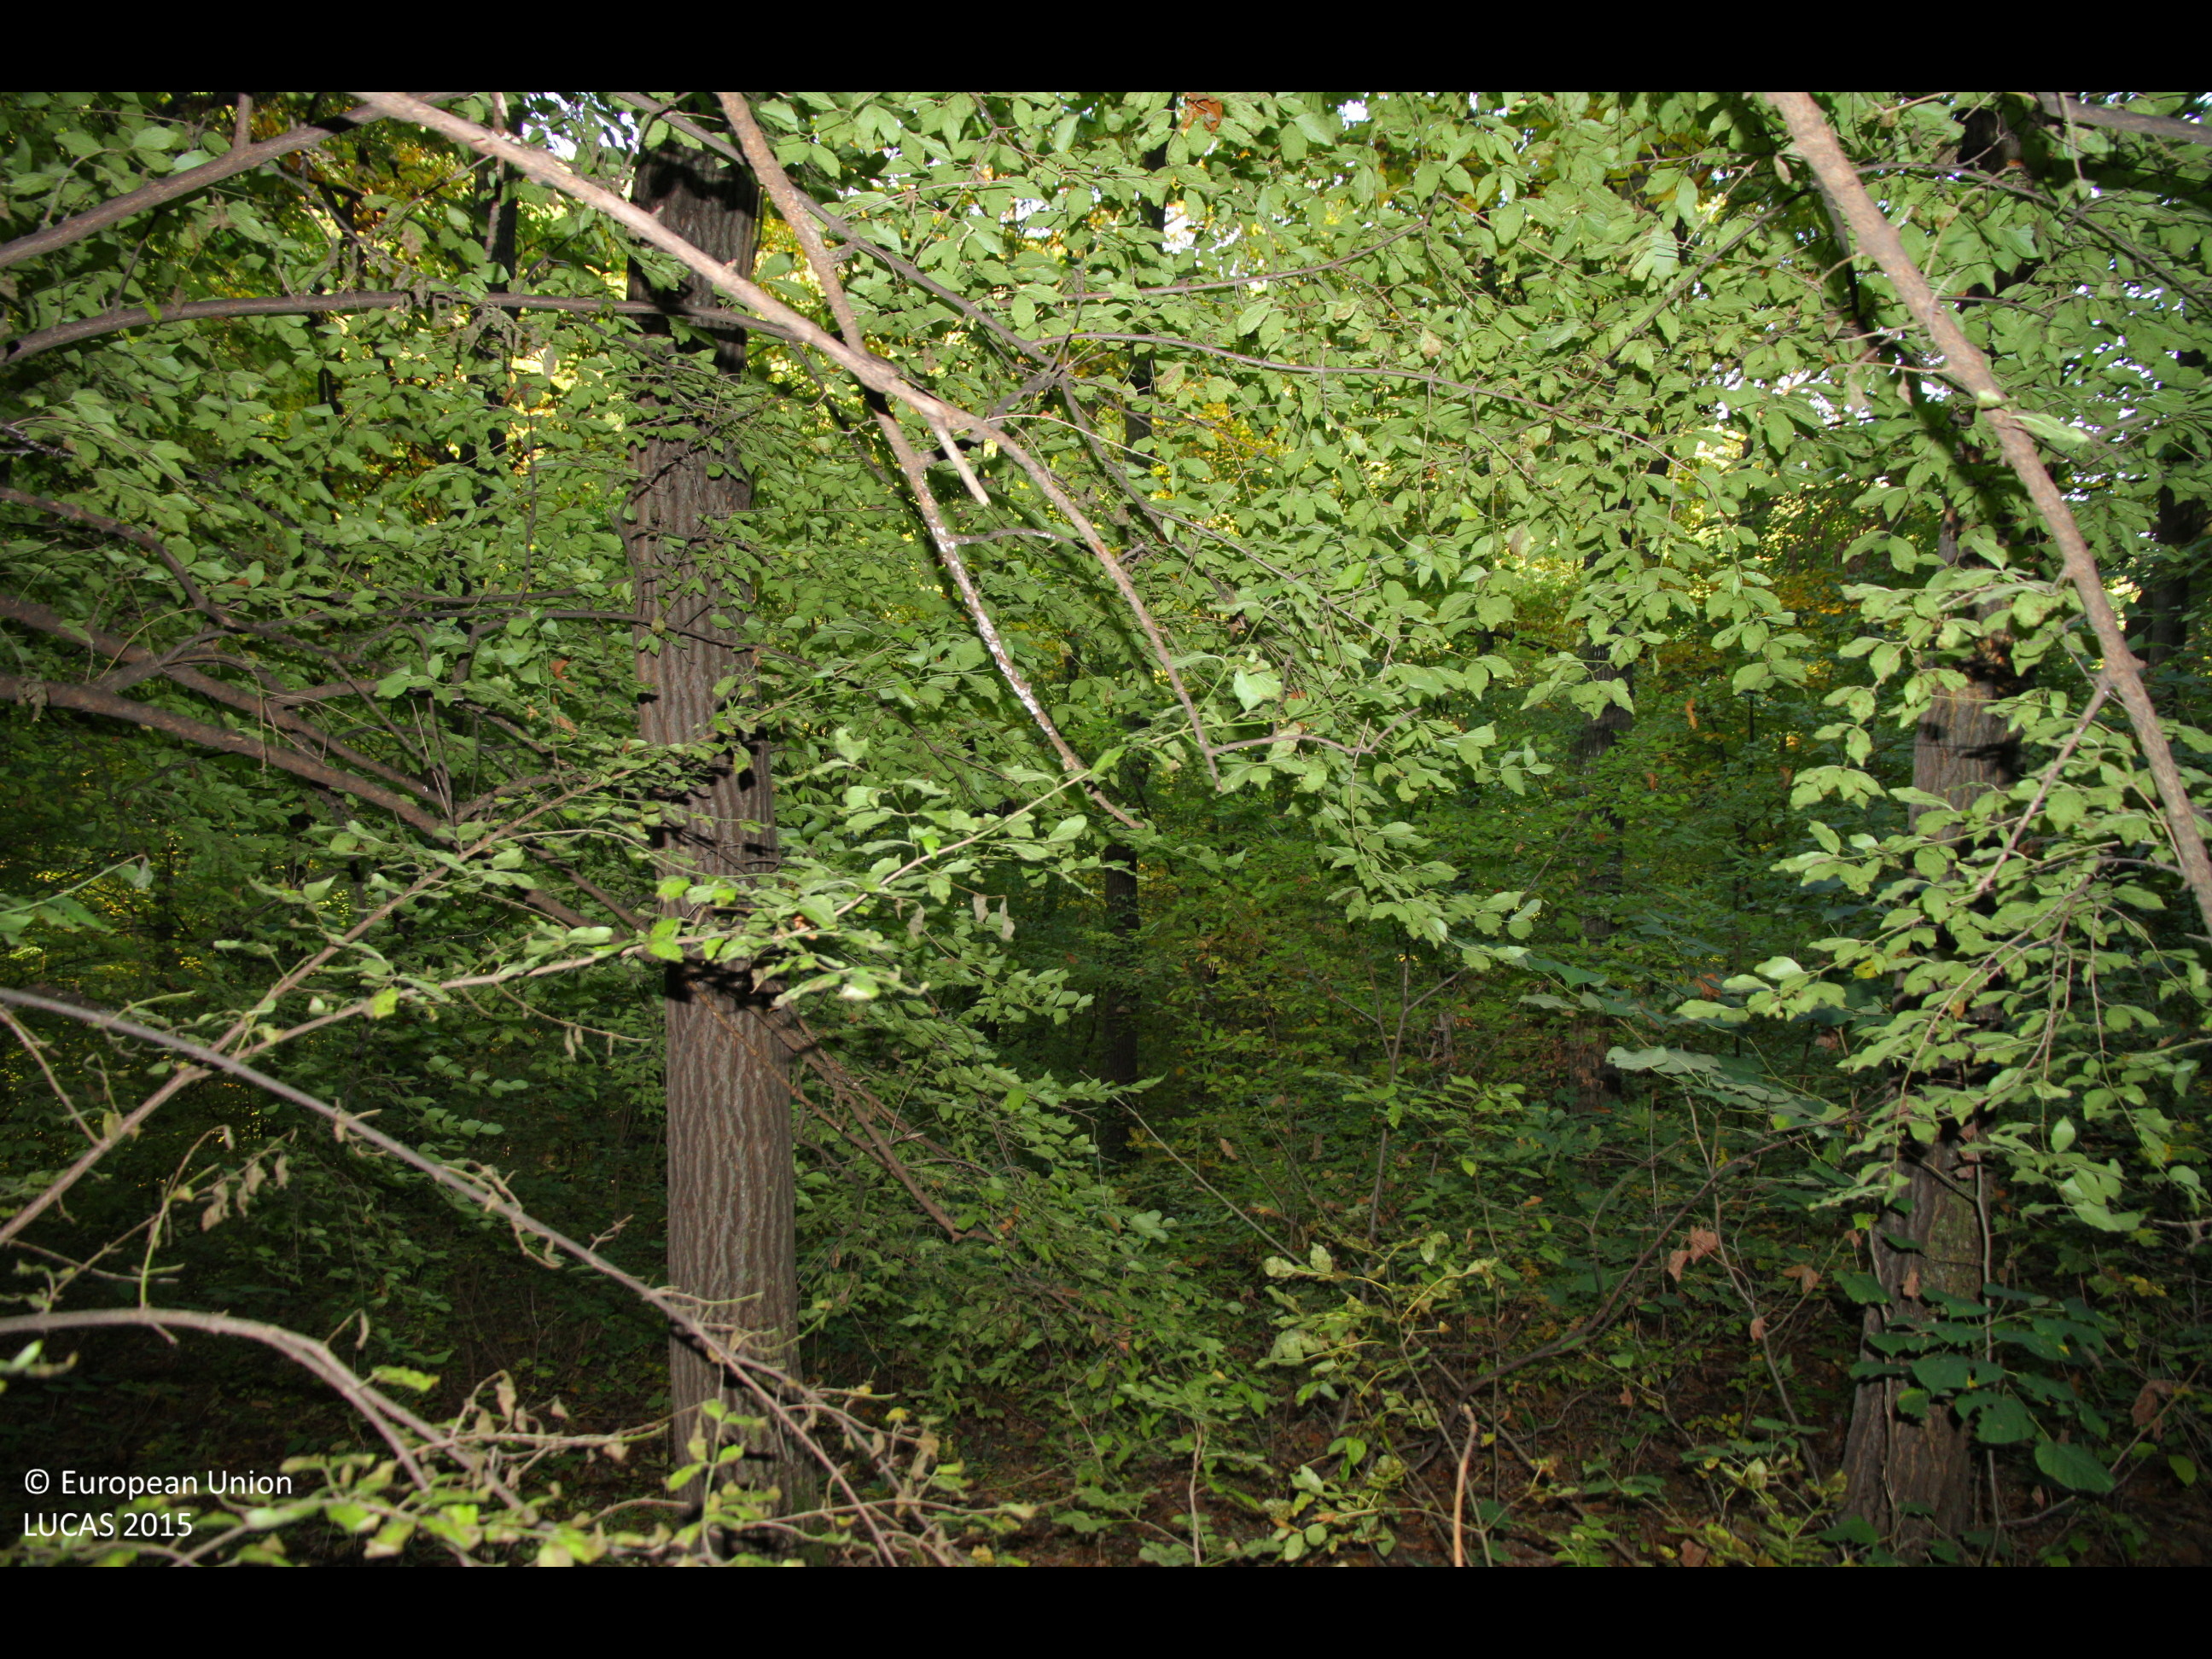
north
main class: Woodland
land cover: Broadleaved woodland
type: mesophytic deciduous forest
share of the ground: > 75 %
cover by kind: broadleaved forest trees 100 %
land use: Forestry
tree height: > 5 m
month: October
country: BG
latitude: 43.0337
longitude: 26.9620
